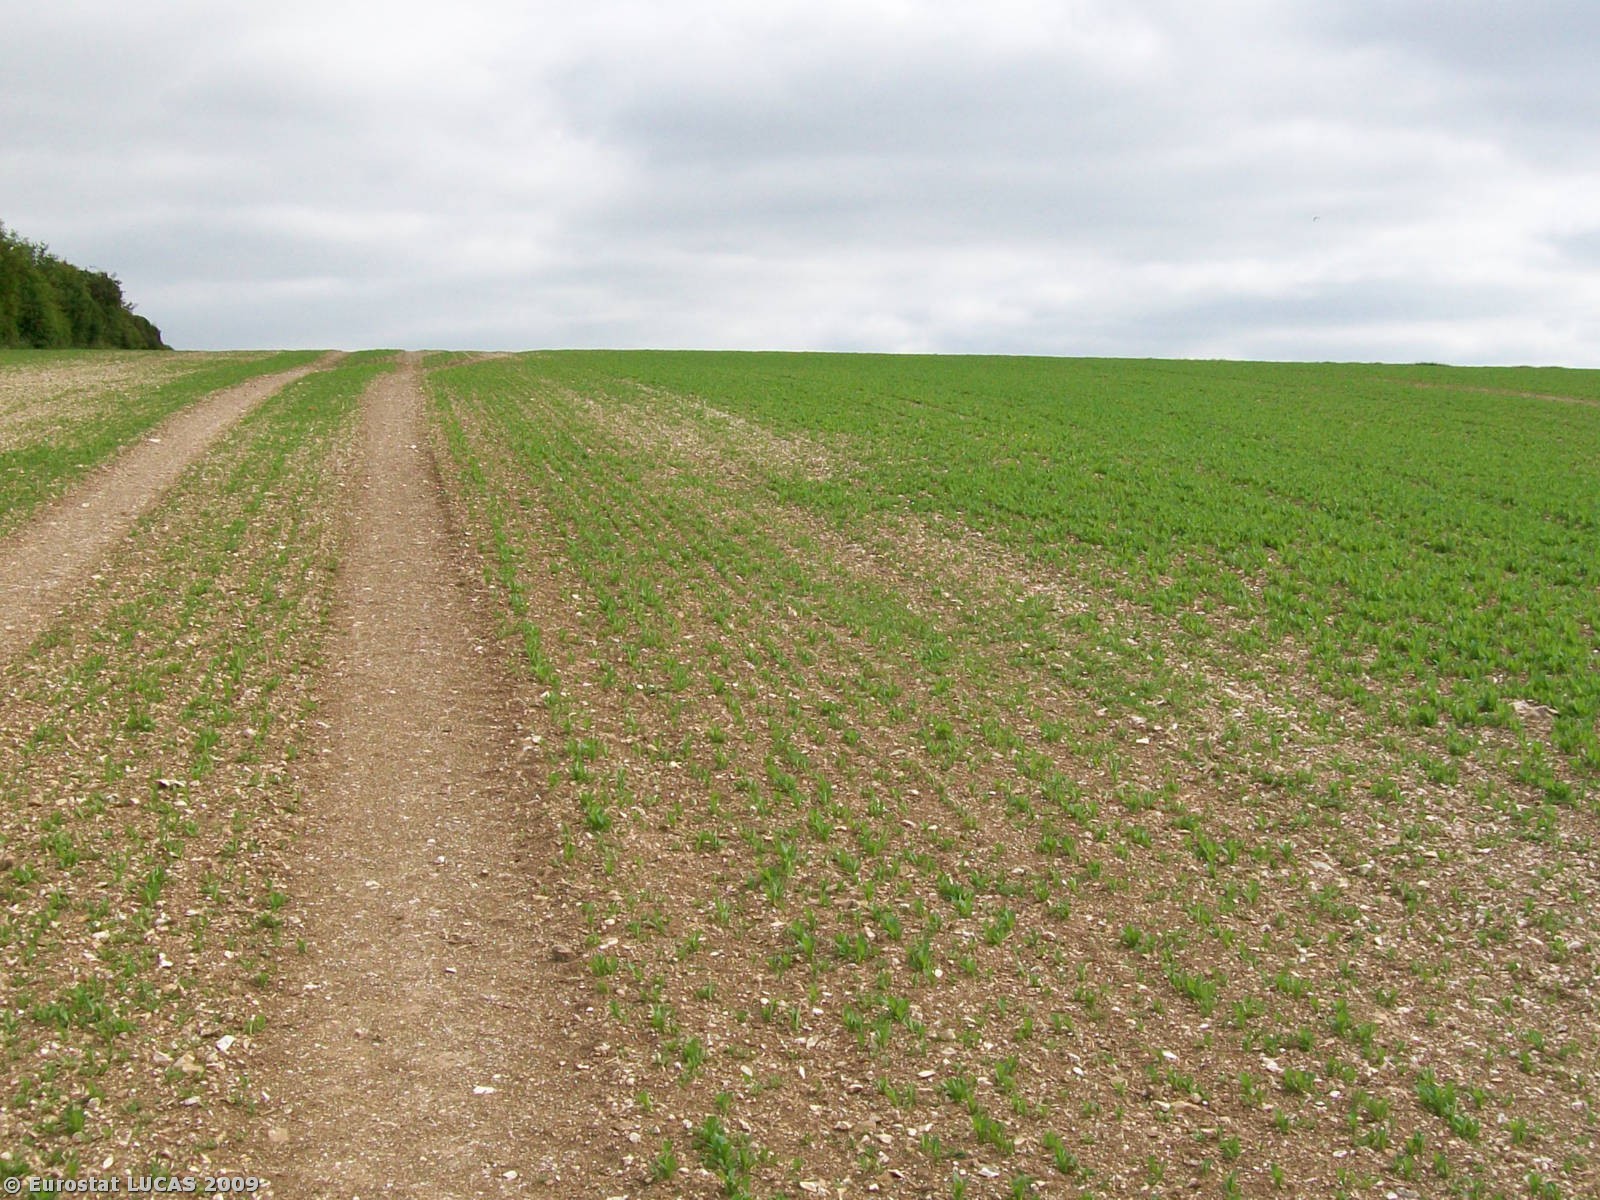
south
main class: Cropland
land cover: Other fibre and oleaginous crops
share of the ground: 25 - 50 %
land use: Agriculture (excluding fallow land and kitchen gardens)
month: May
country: GB
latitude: 50.8976
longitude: -2.1317
